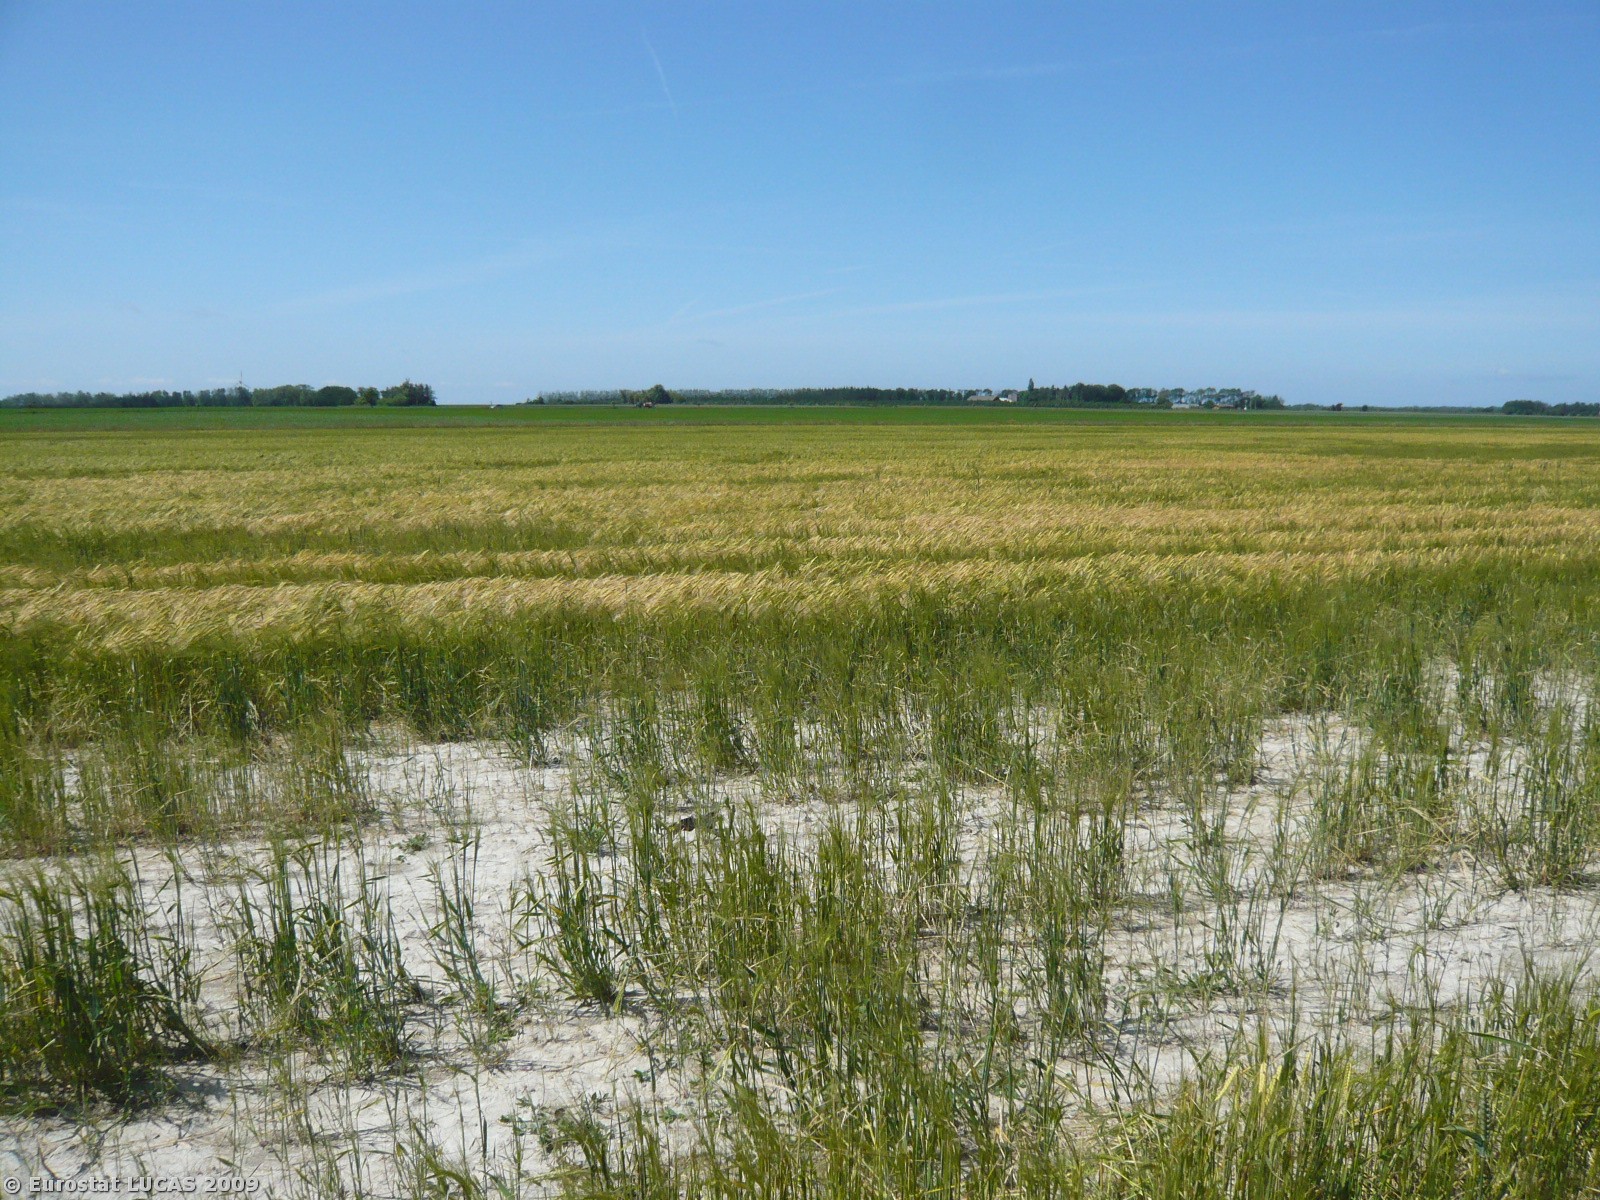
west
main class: Cropland
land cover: Barley
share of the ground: 50 - 75 %
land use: Agriculture (excluding fallow land and kitchen gardens)
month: June
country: DK
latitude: 54.7069
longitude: 11.3183
